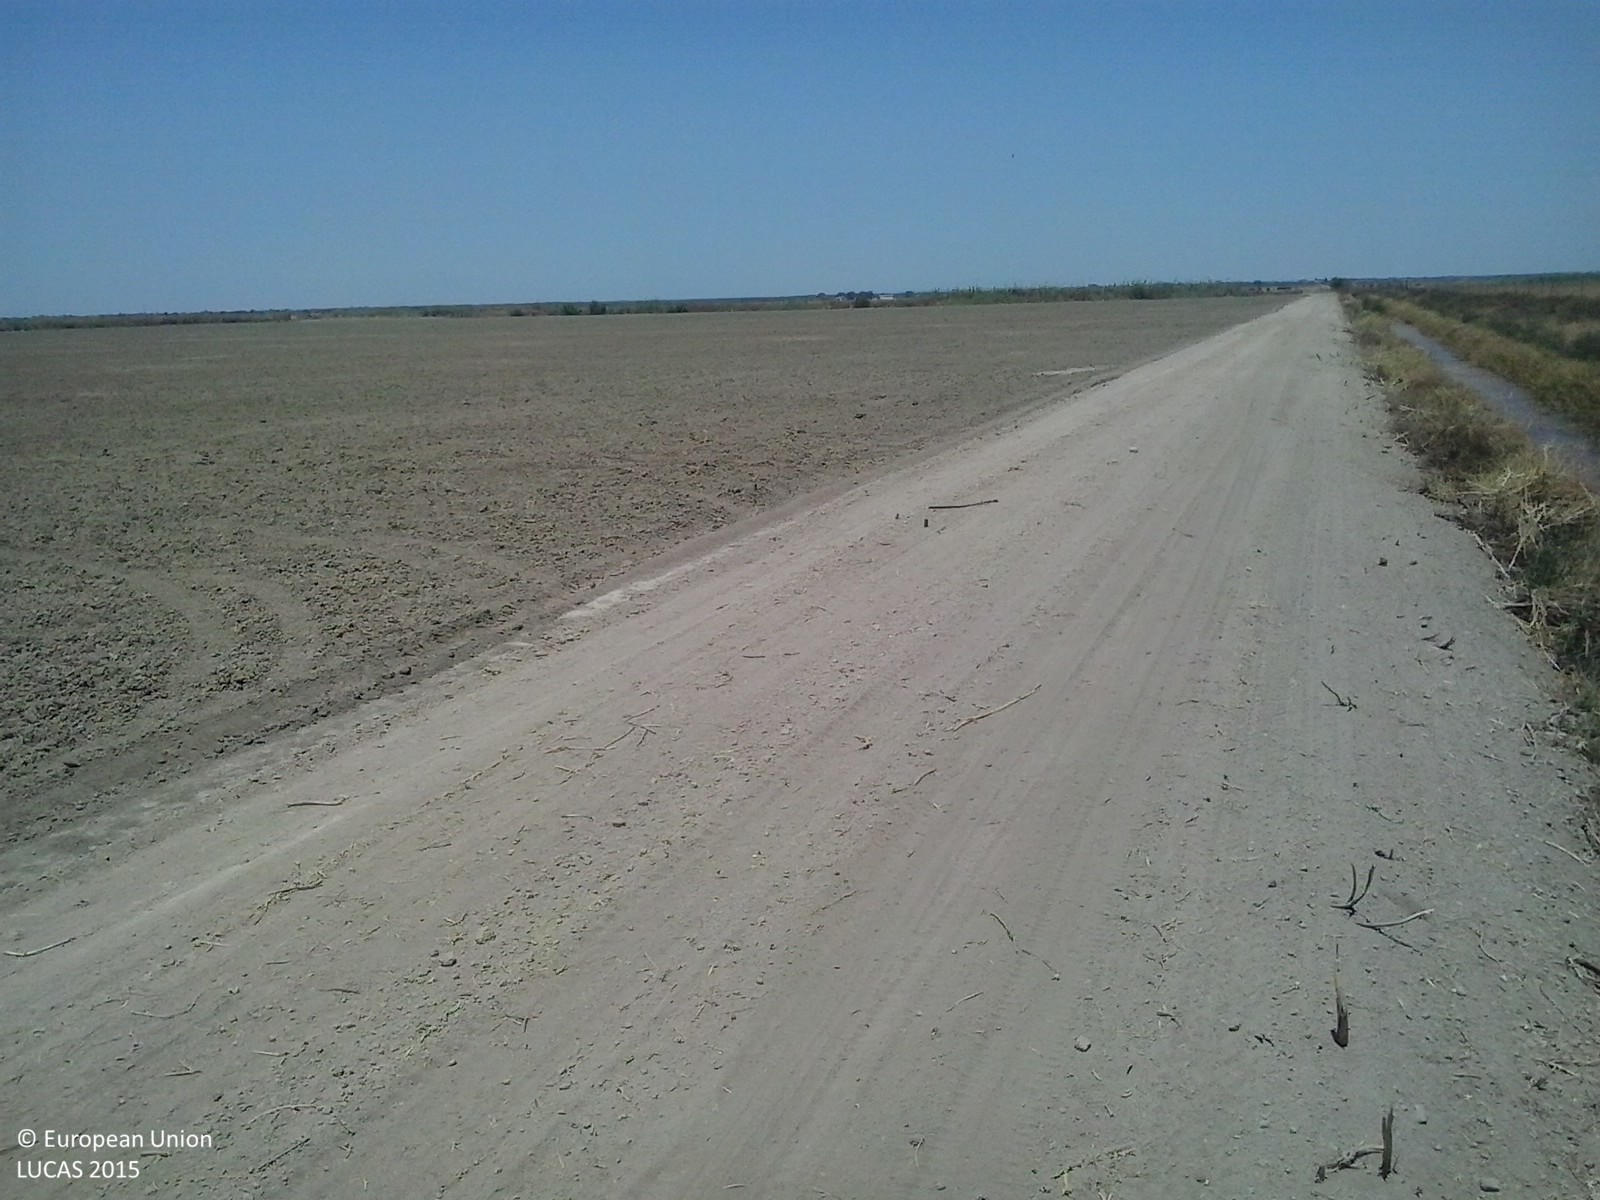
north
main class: Grassland
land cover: Spontaneously vegetated surfaces
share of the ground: > 75 %
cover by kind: herbaceous plants 100 %
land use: Fallow land
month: July
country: ES
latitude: 37.1226
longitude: -6.3100
